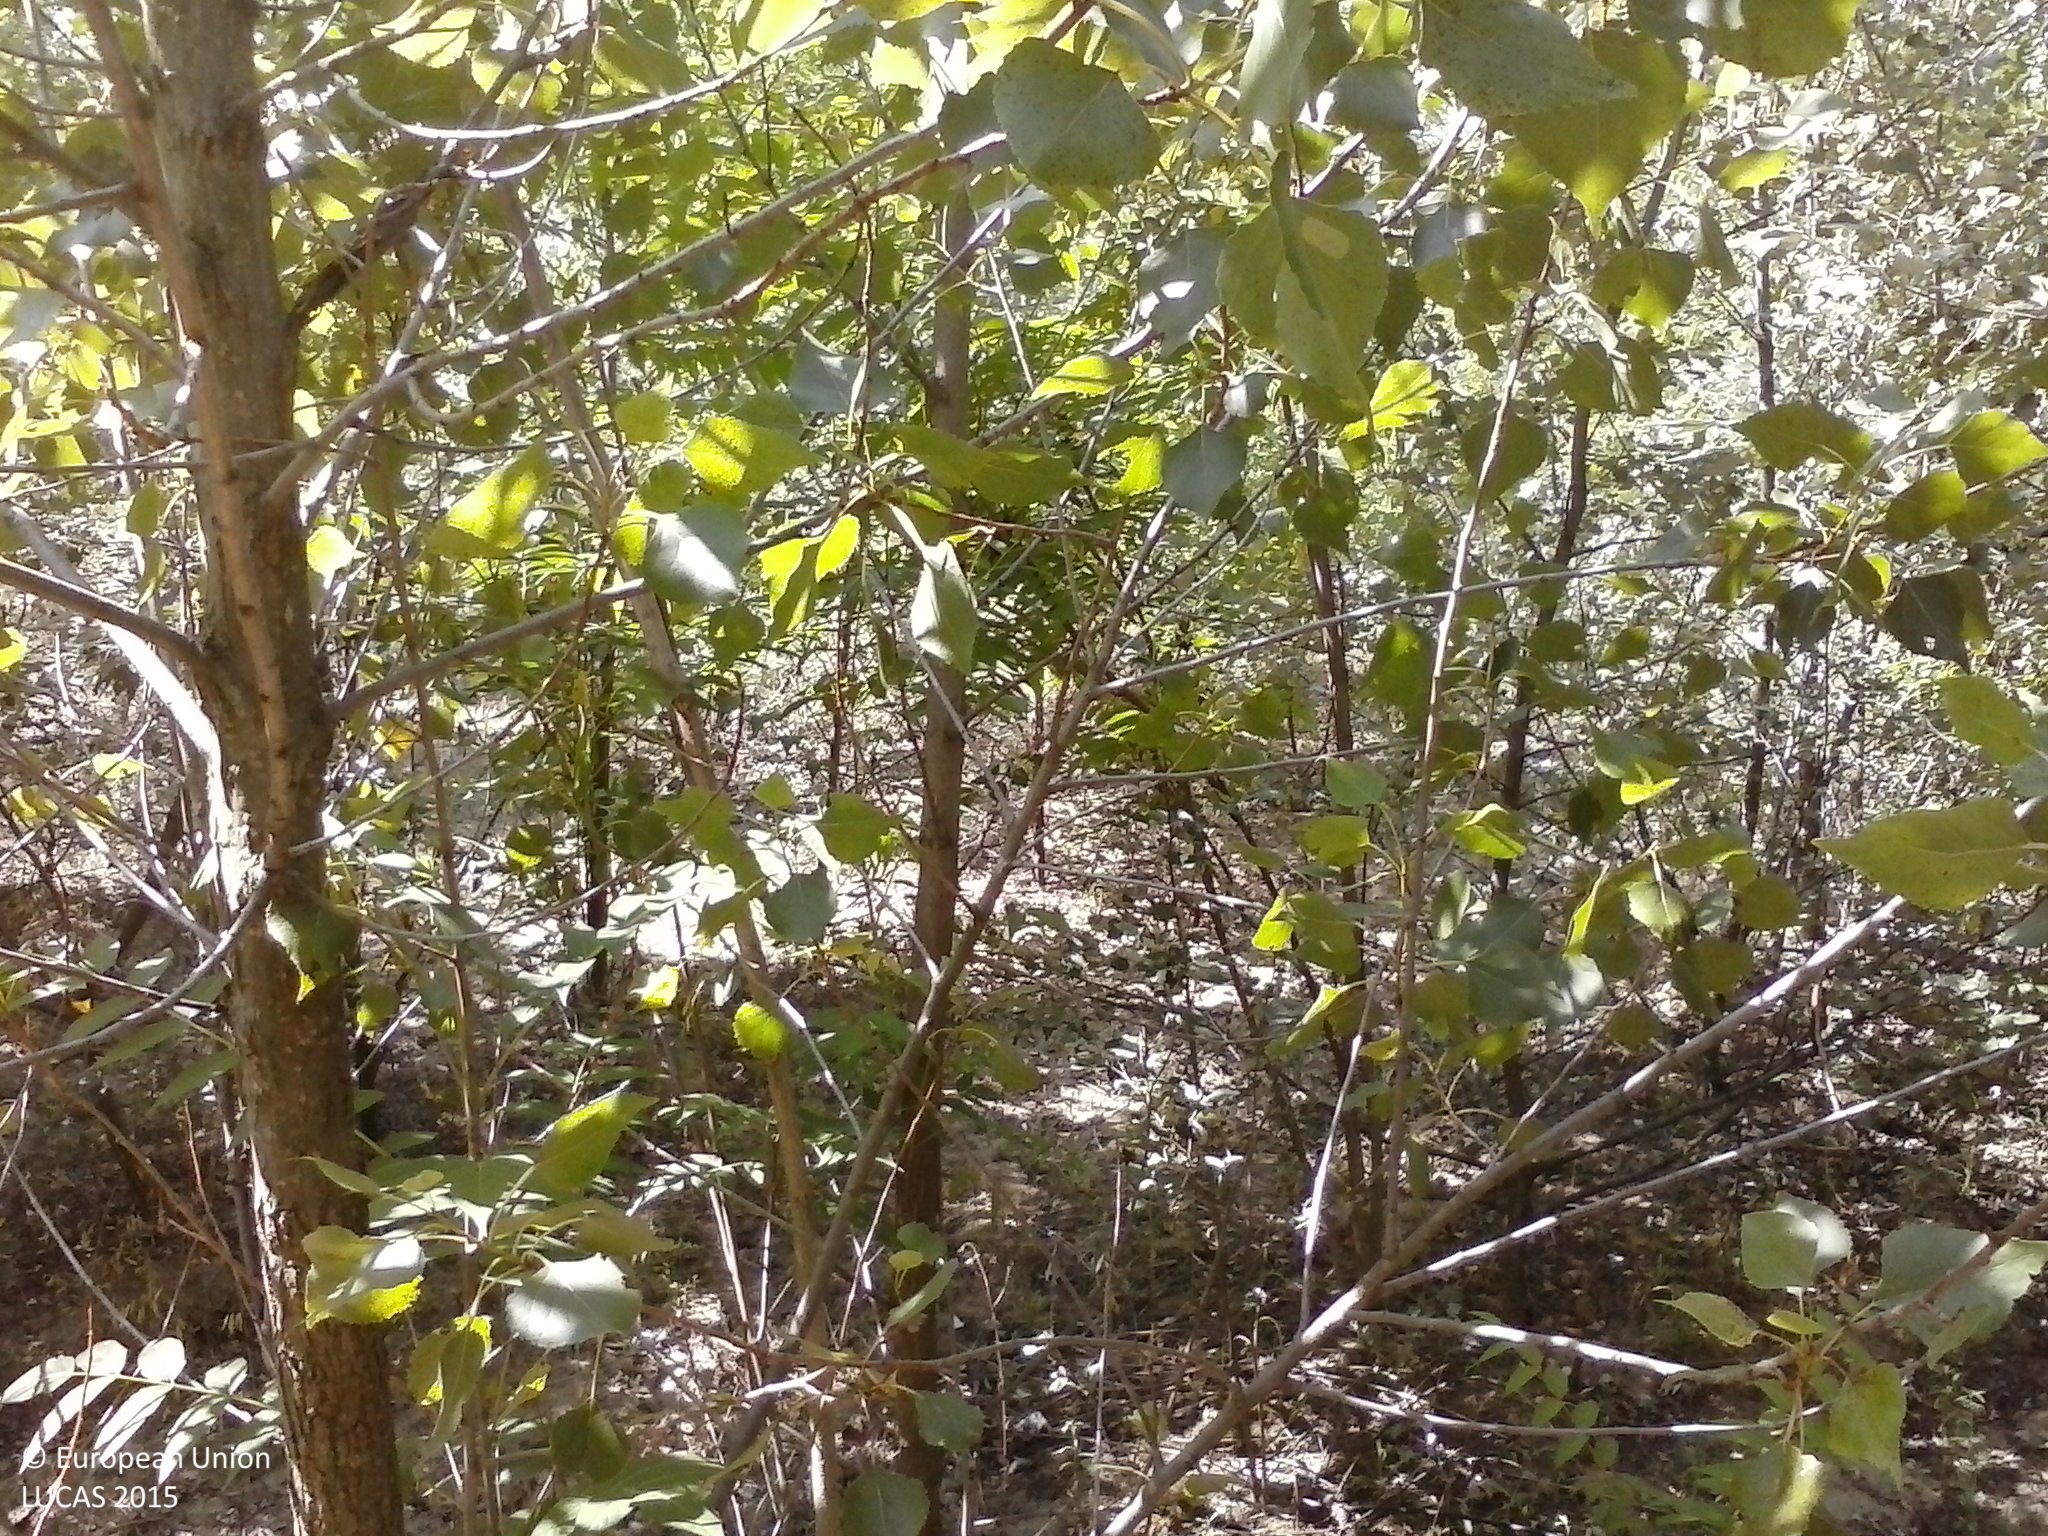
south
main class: Woodland
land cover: Broadleaved woodland
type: exotic forest
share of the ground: > 75 %
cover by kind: broadleaved forest trees 95 %, consolidated bare surface 5 %
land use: Forestry
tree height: < 5 m
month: July
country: HU
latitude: 46.2758
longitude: 19.6597
